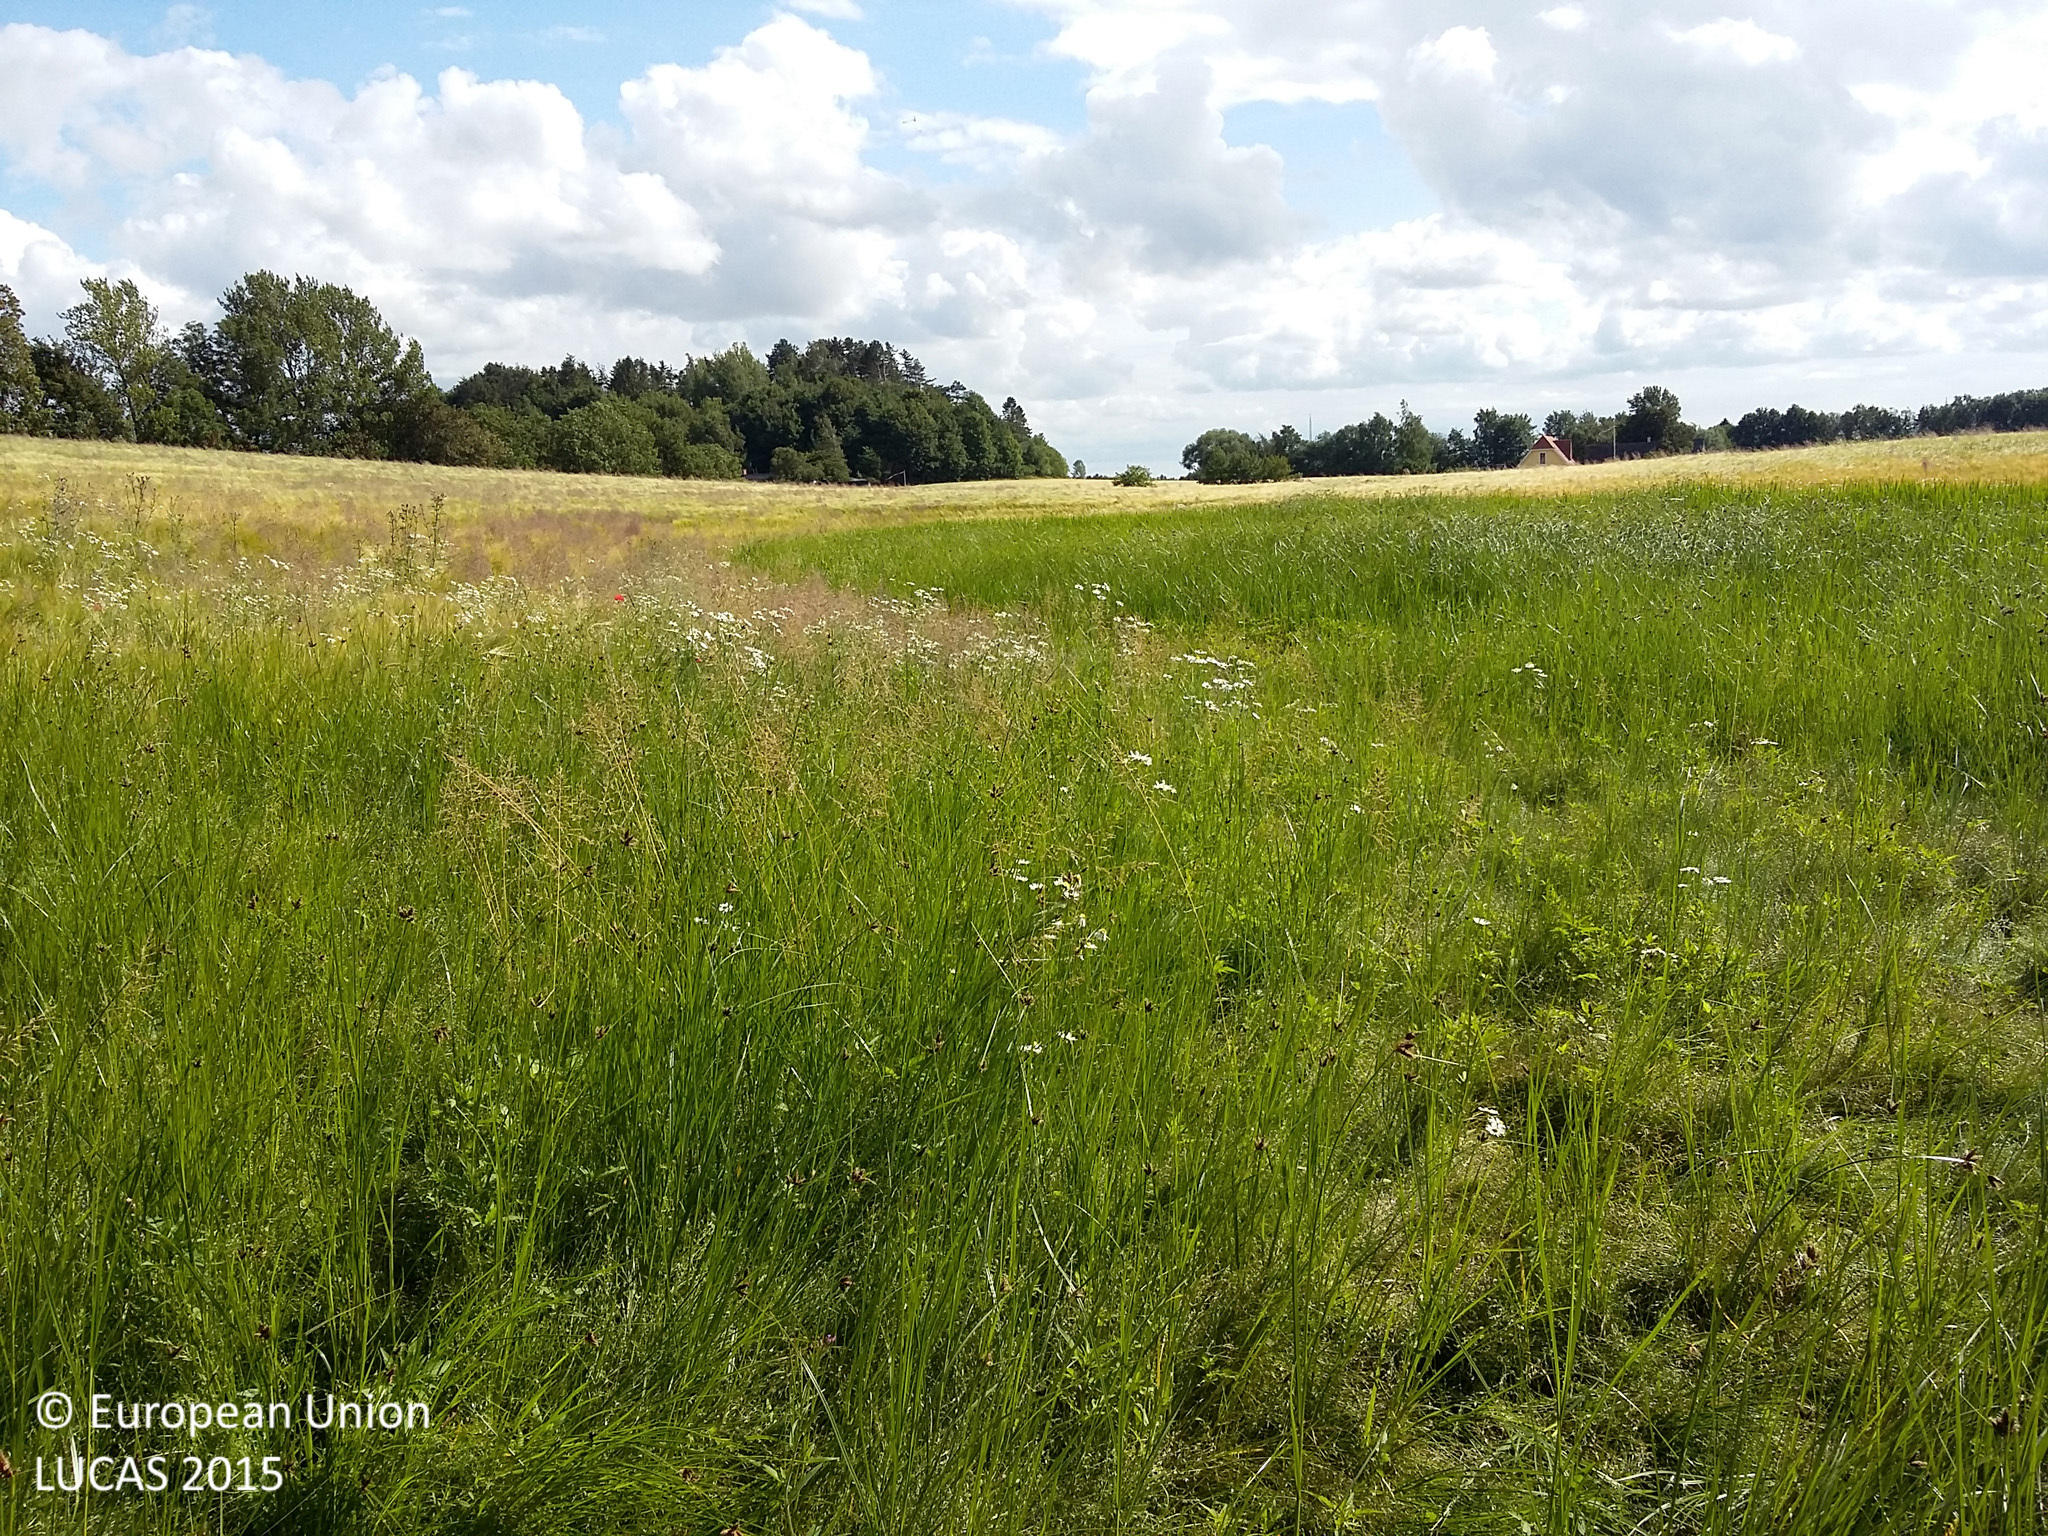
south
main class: Woodland
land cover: Broadleaved woodland
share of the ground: > 75 %
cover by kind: broadleaved forest trees 80 %, herbaceous plants 20 %
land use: Semi-natural and natural areas not in use
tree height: > 5 m
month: July
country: DK
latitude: 55.8013
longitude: 11.5140
